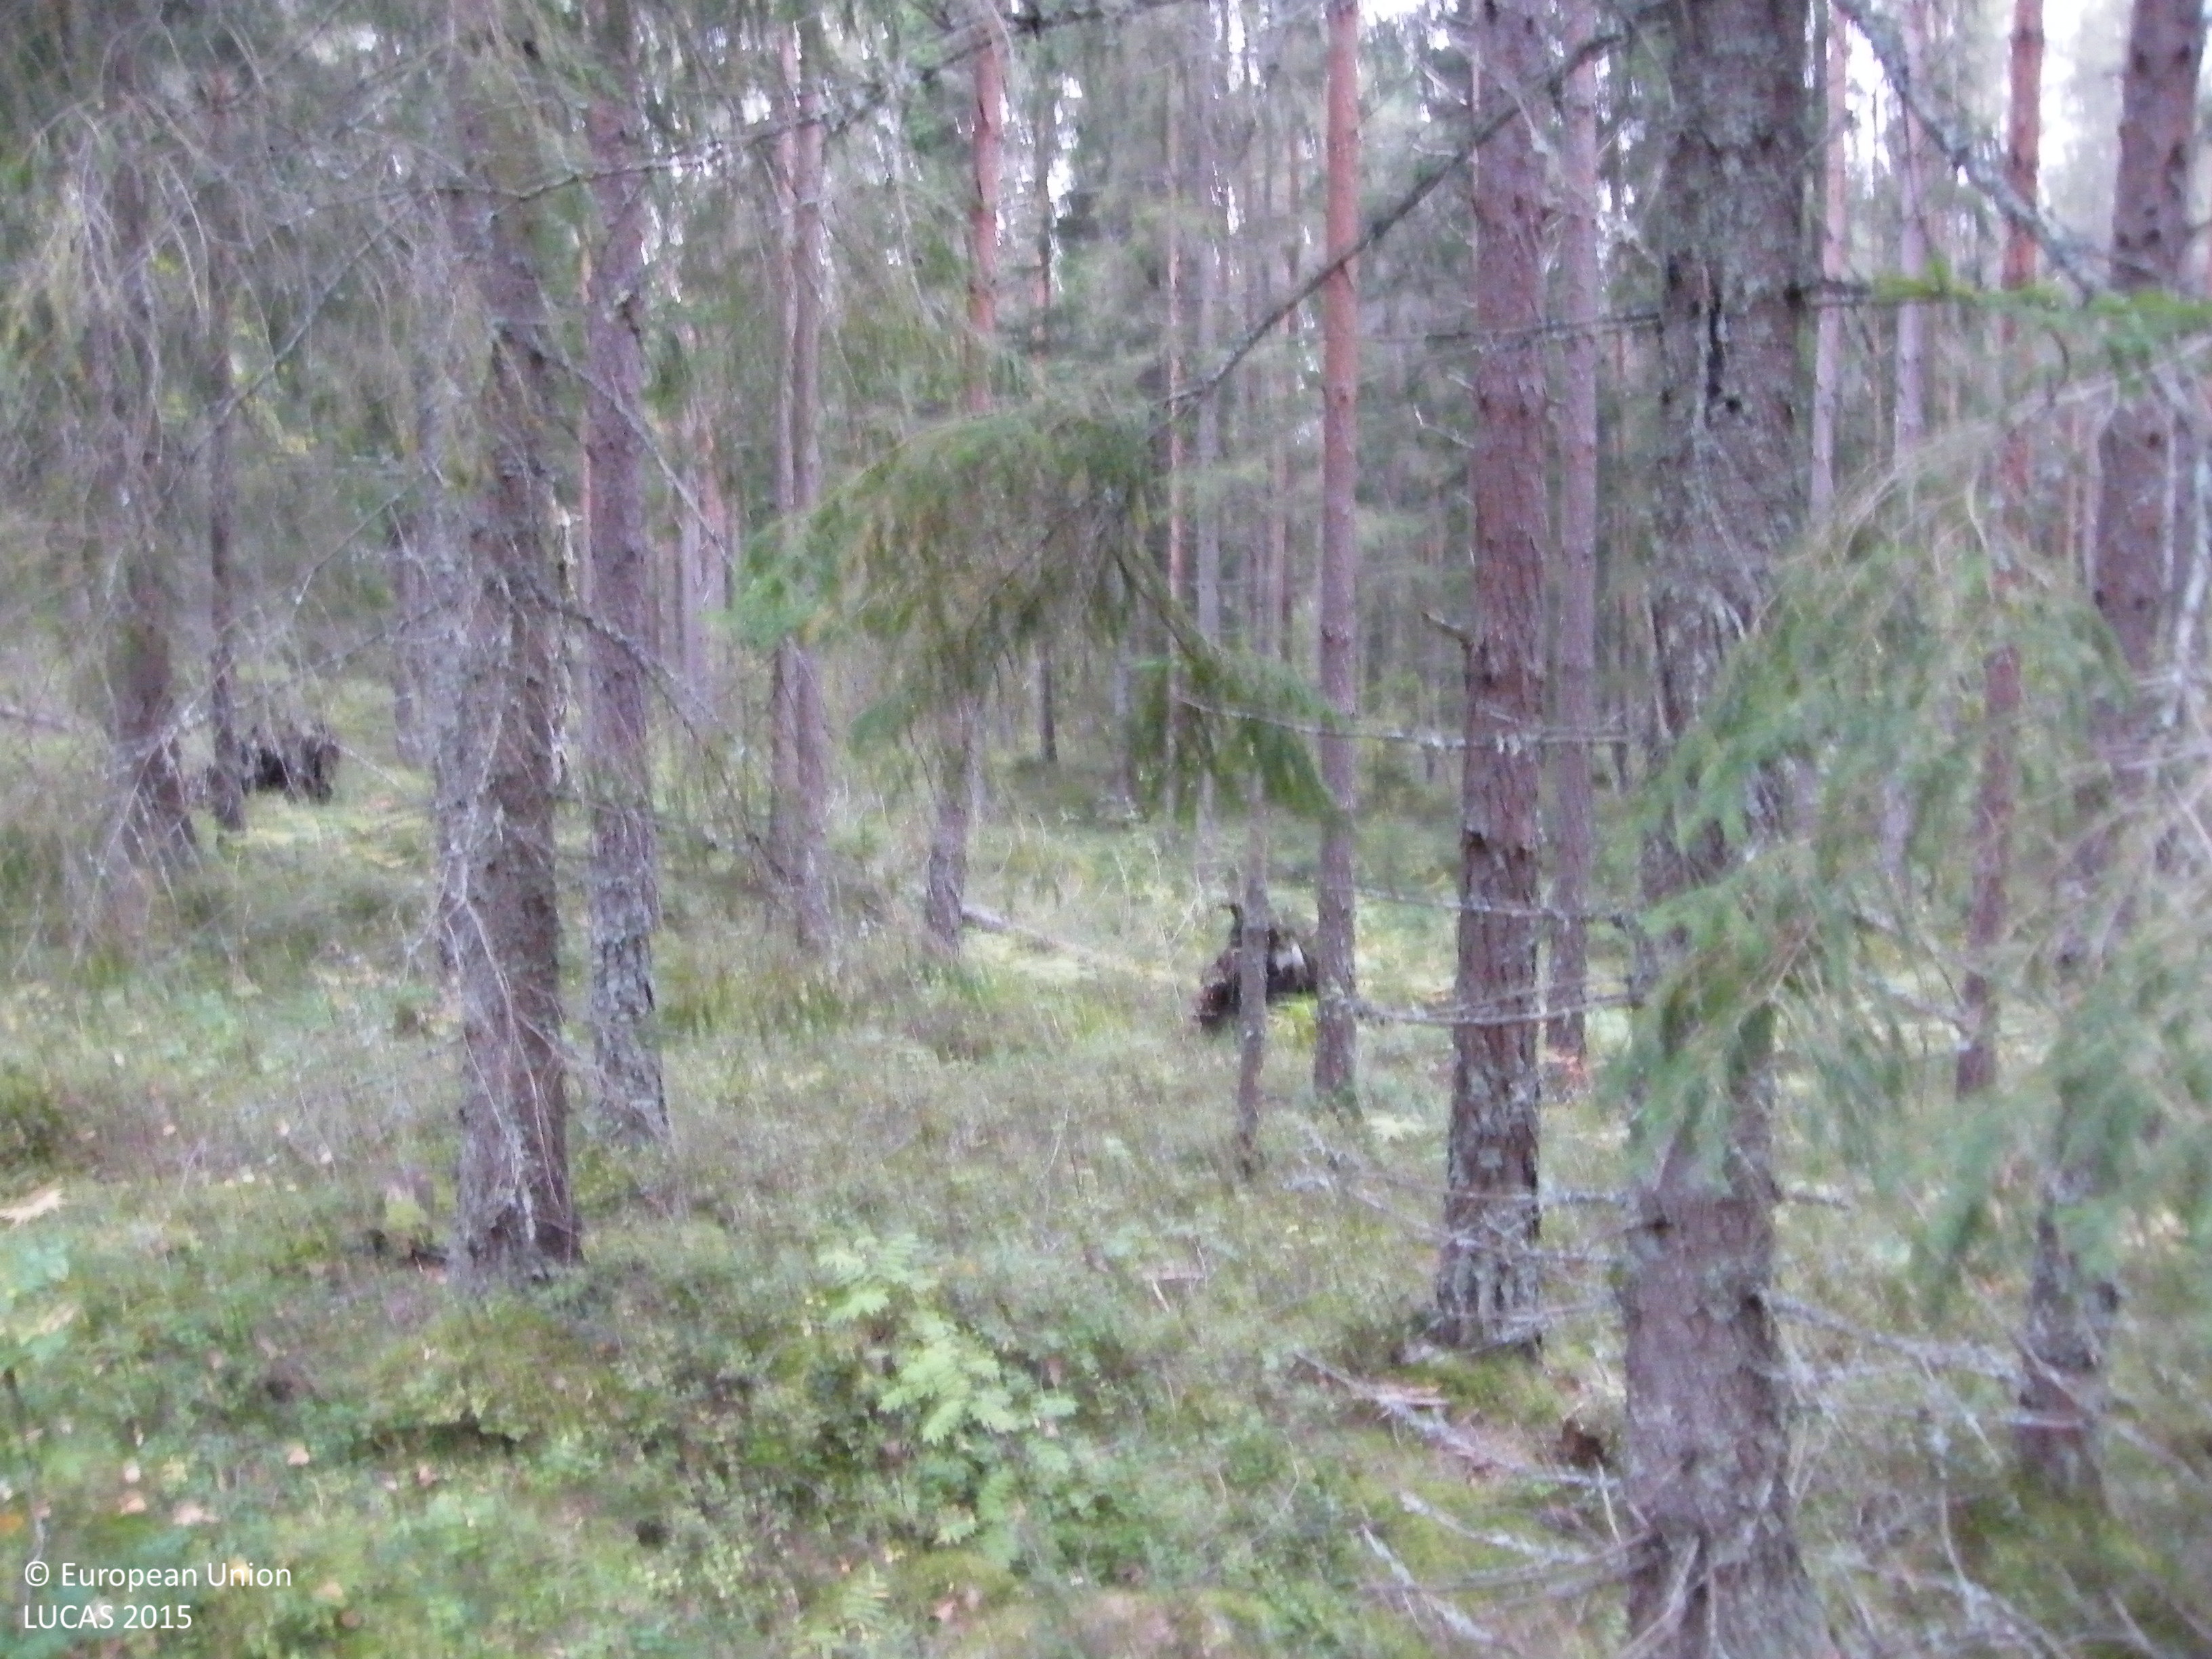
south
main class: Woodland
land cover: Other mixed woodland
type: boreal forest
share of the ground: 50 - 75 %
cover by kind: coniferous forest trees 45 %, broadleaved forest trees 20 %, shrubs 20 %, lichens and mosses 15 %
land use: Forestry
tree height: > 5 m
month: September
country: SE
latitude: 59.7311
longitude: 15.4862
